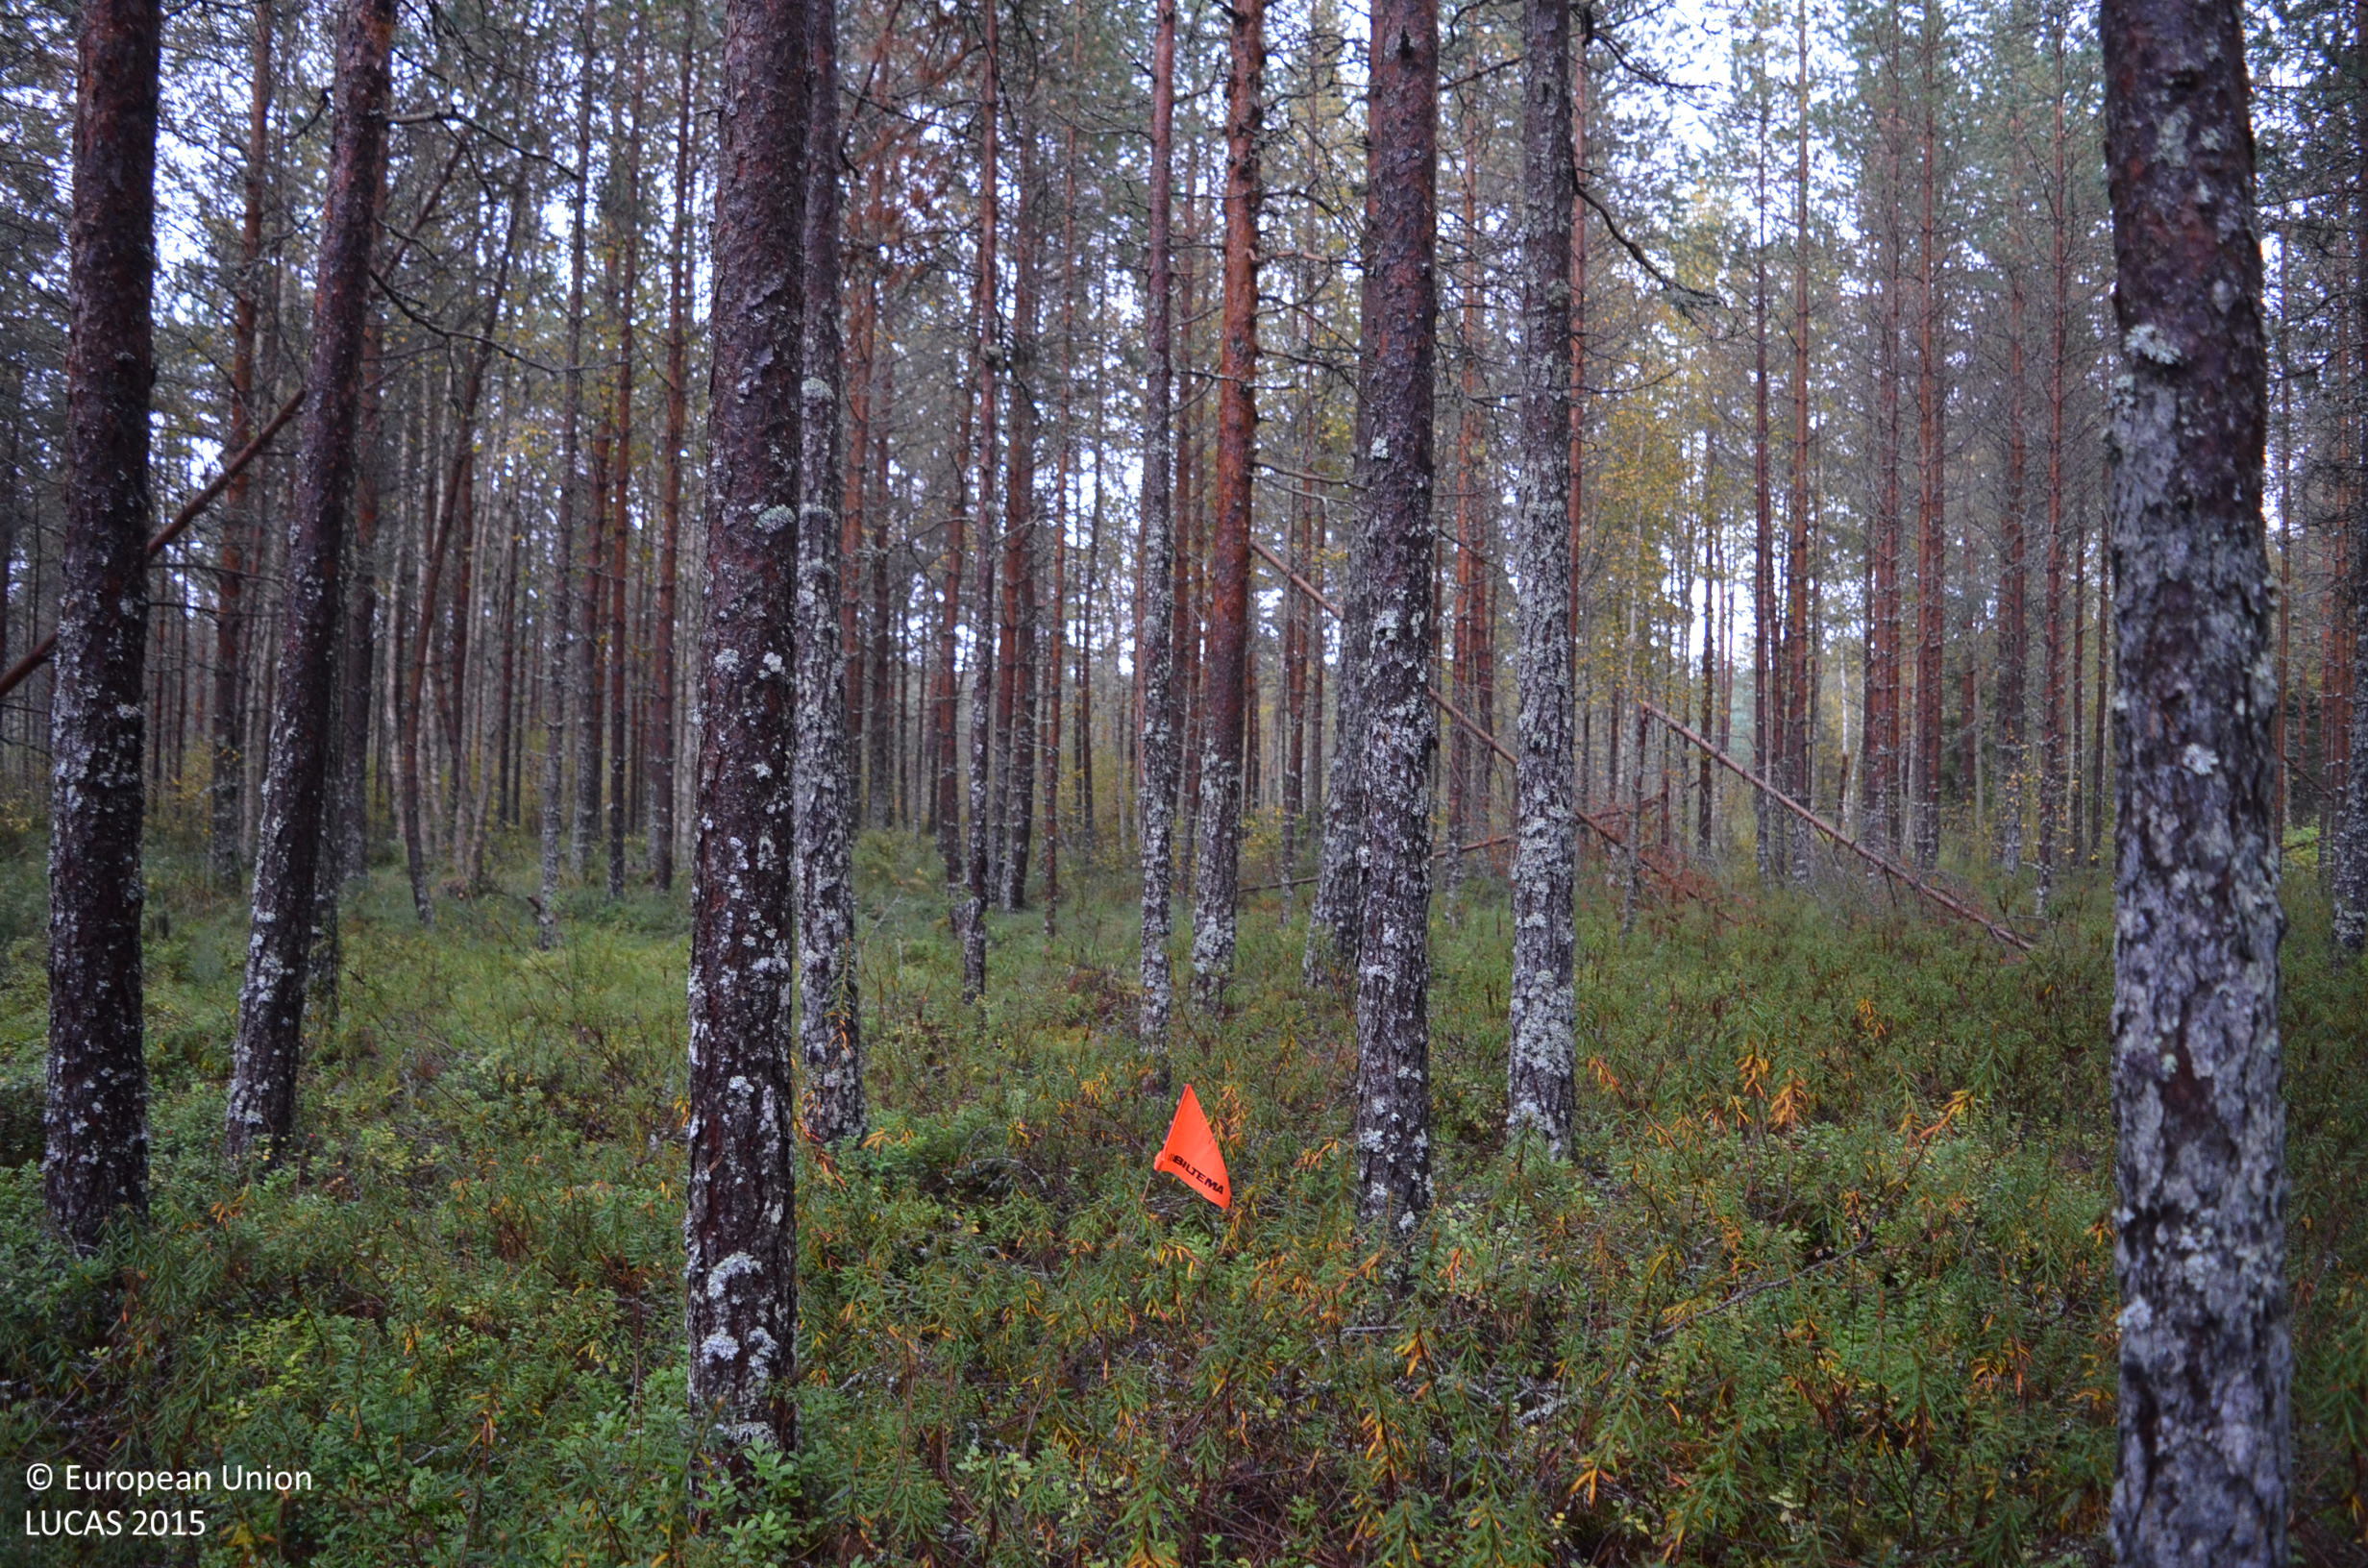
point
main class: Woodland
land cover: Pine dominated coniferous woodland
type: boreal forest
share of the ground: > 75 %
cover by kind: coniferous forest trees 65 %, shrubs 25 %, broadleaved forest trees 10 %
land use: Forestry
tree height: > 5 m
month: September
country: FI
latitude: 62.8854
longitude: 23.8602
